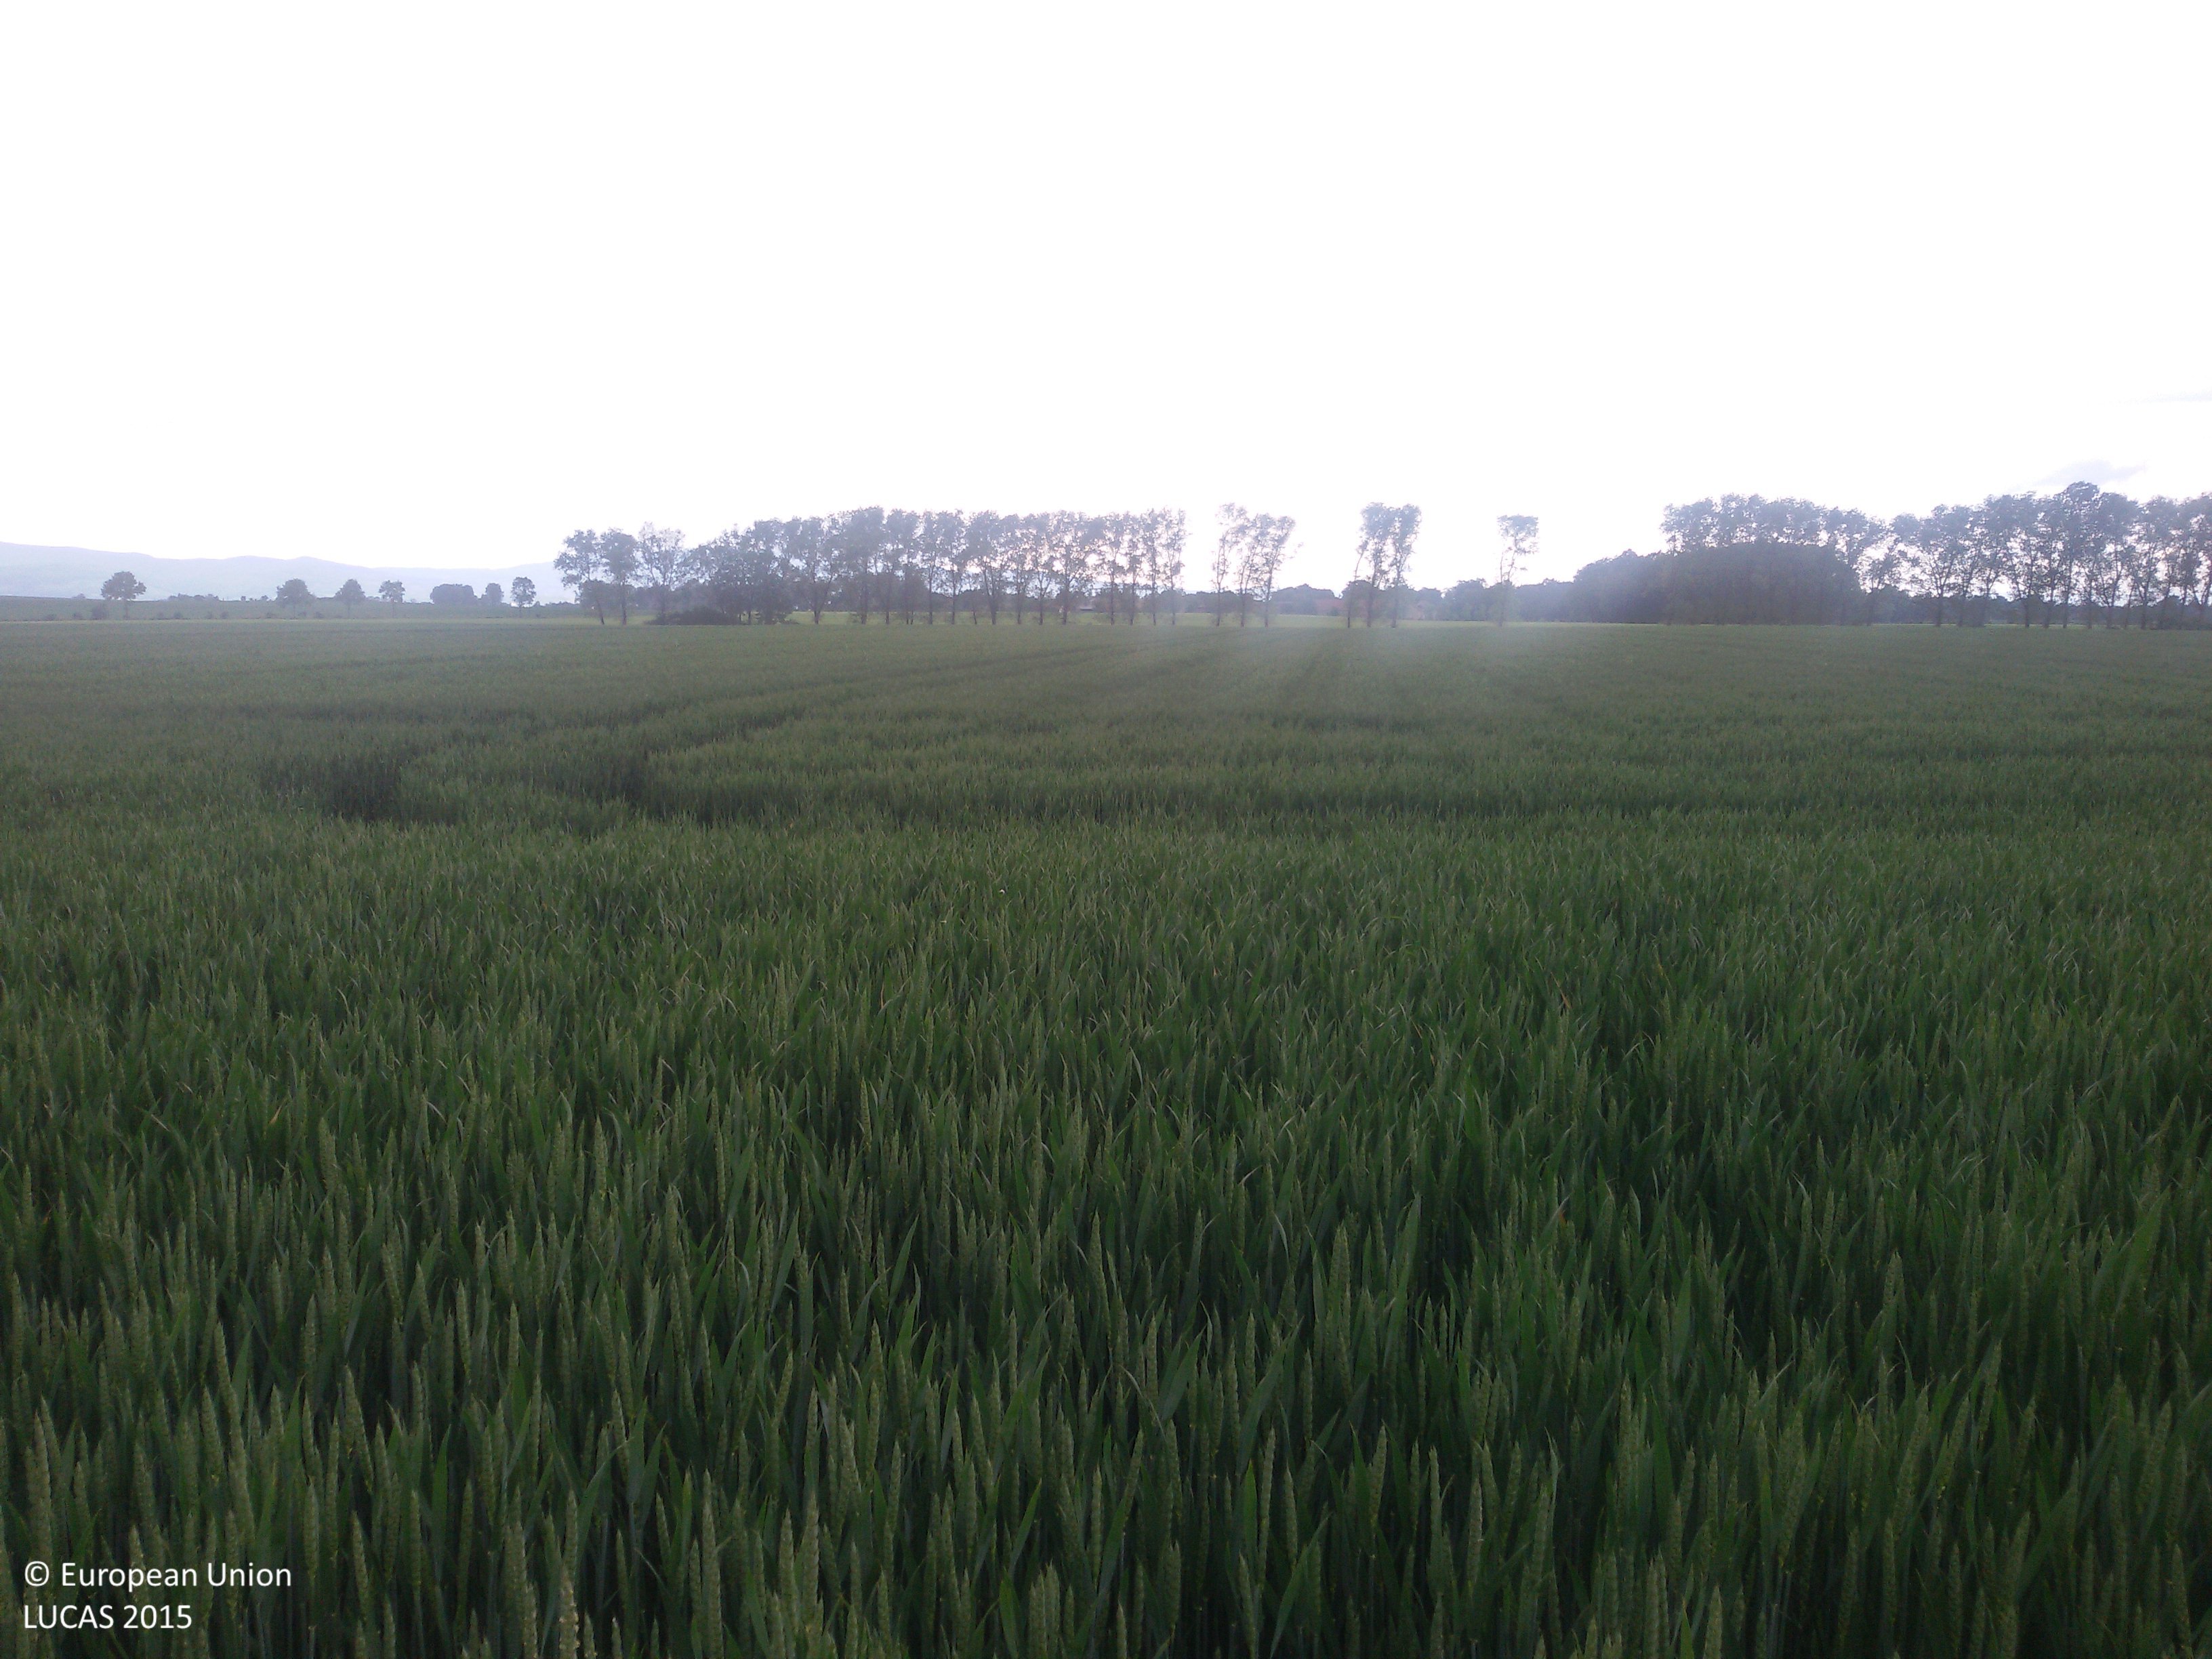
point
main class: Cropland
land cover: Common wheat
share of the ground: > 75 %
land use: Agriculture (excluding fallow land and kitchen gardens)
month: May
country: PL
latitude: 50.4095
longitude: 17.1732
